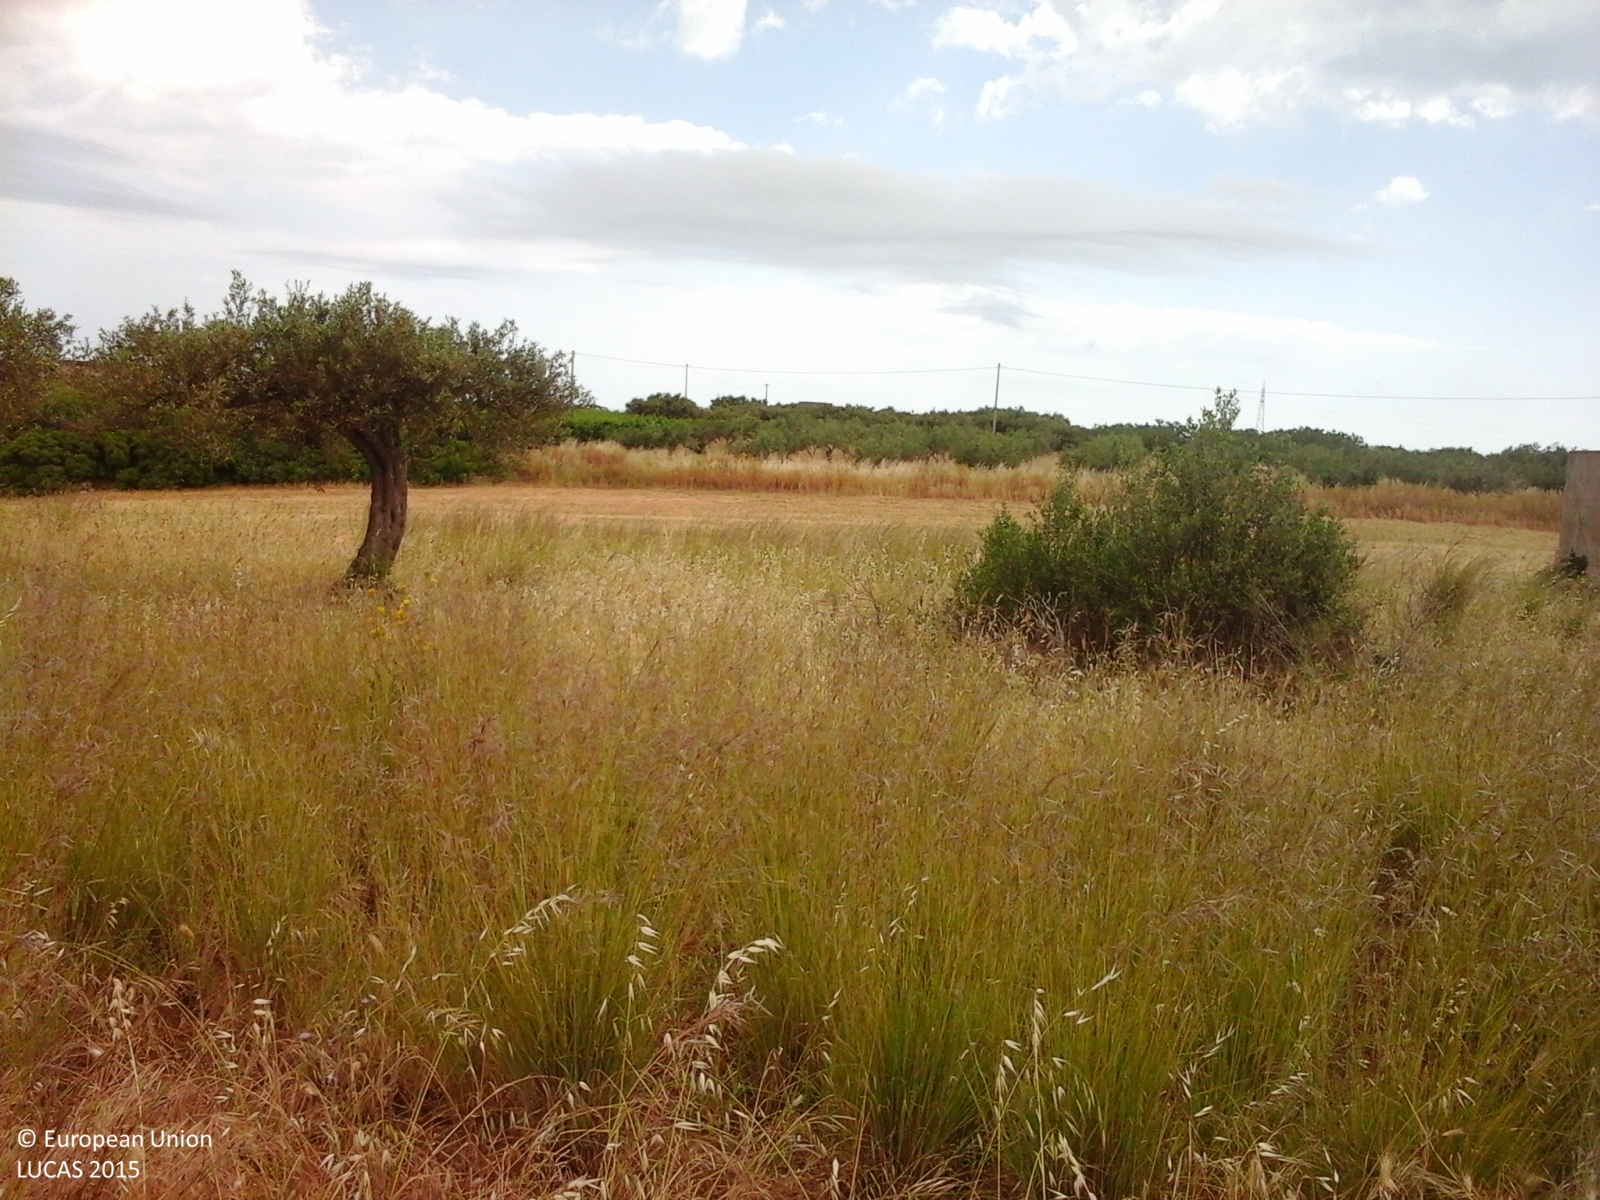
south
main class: Grassland
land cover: Spontaneously vegetated surfaces
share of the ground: > 75 %
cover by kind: herbaceous plants 90 %, consolidated bare surface 10 %
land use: Agriculture (excluding fallow land and kitchen gardens)
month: May
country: IT
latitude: 37.6121
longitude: 12.9119
